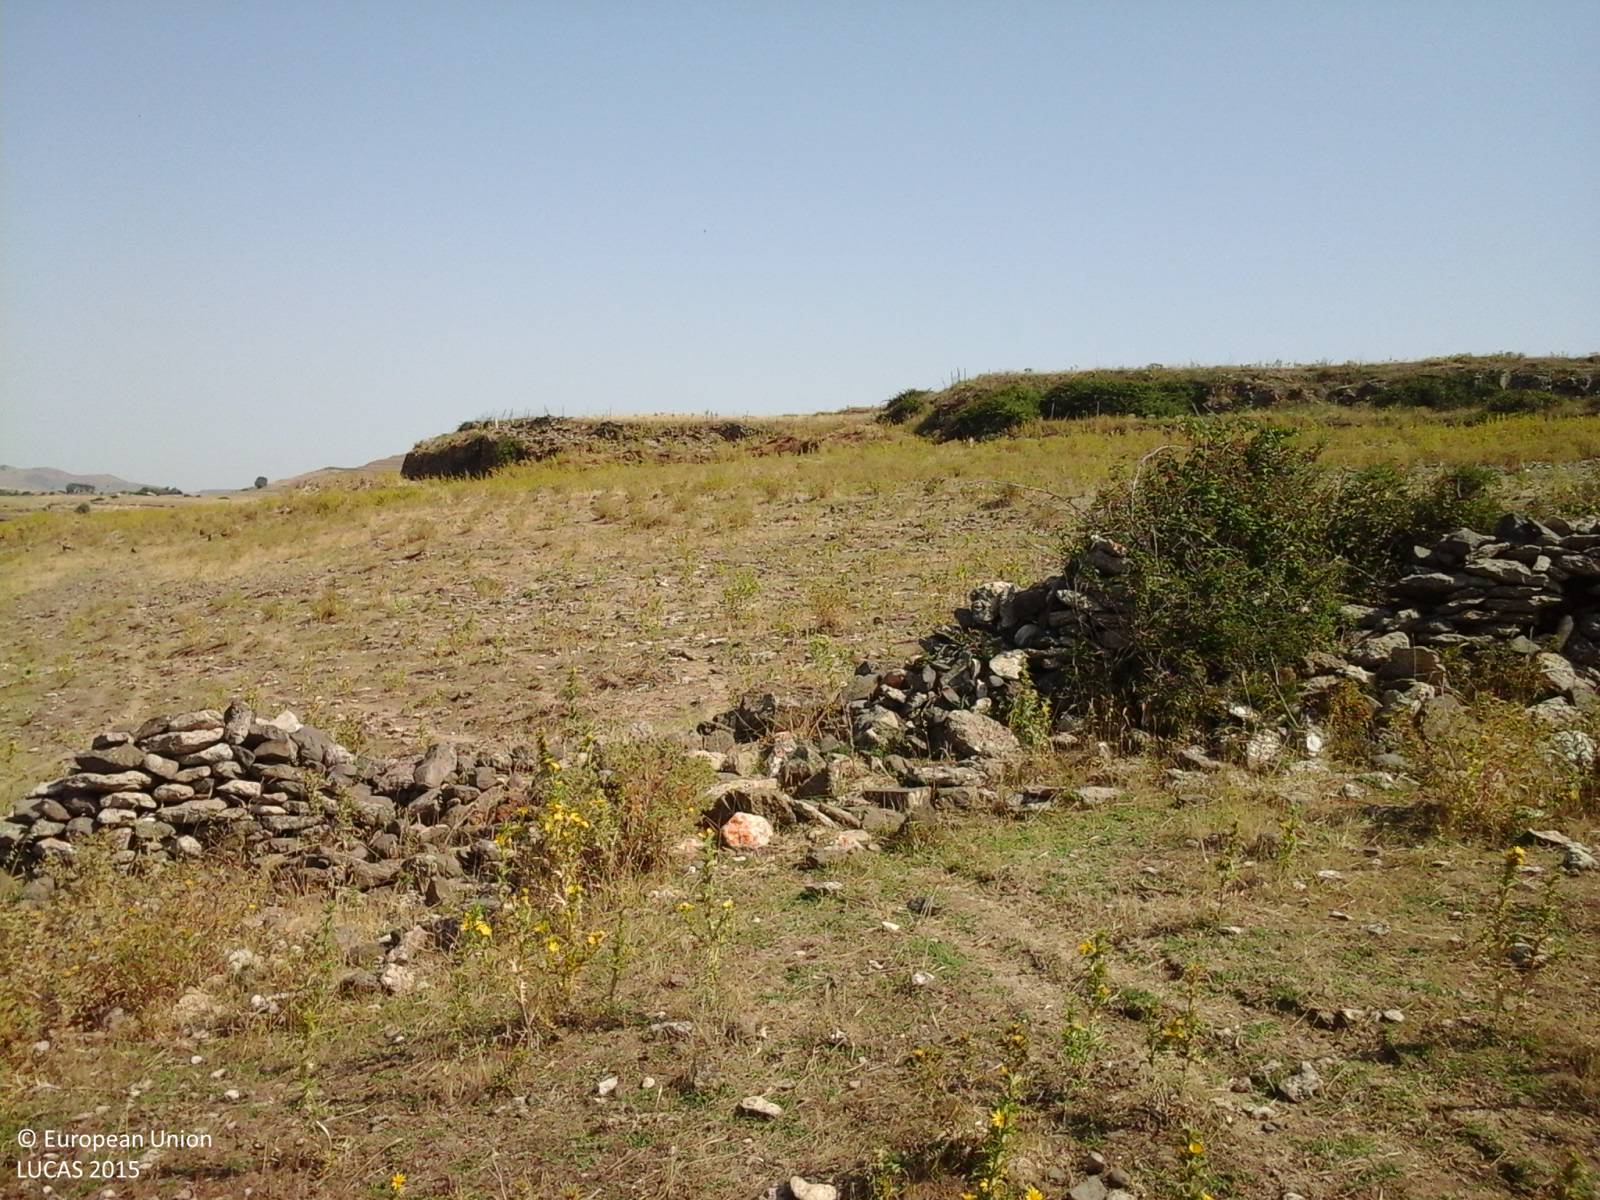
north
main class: Grassland
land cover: Grassland without tree/shrub cover
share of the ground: > 75 %
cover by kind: herbaceous plants 95 %, consolidated bare surface 5 %
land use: Agriculture (excluding fallow land and kitchen gardens)
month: July
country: IT
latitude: 40.4222
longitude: 8.7453
